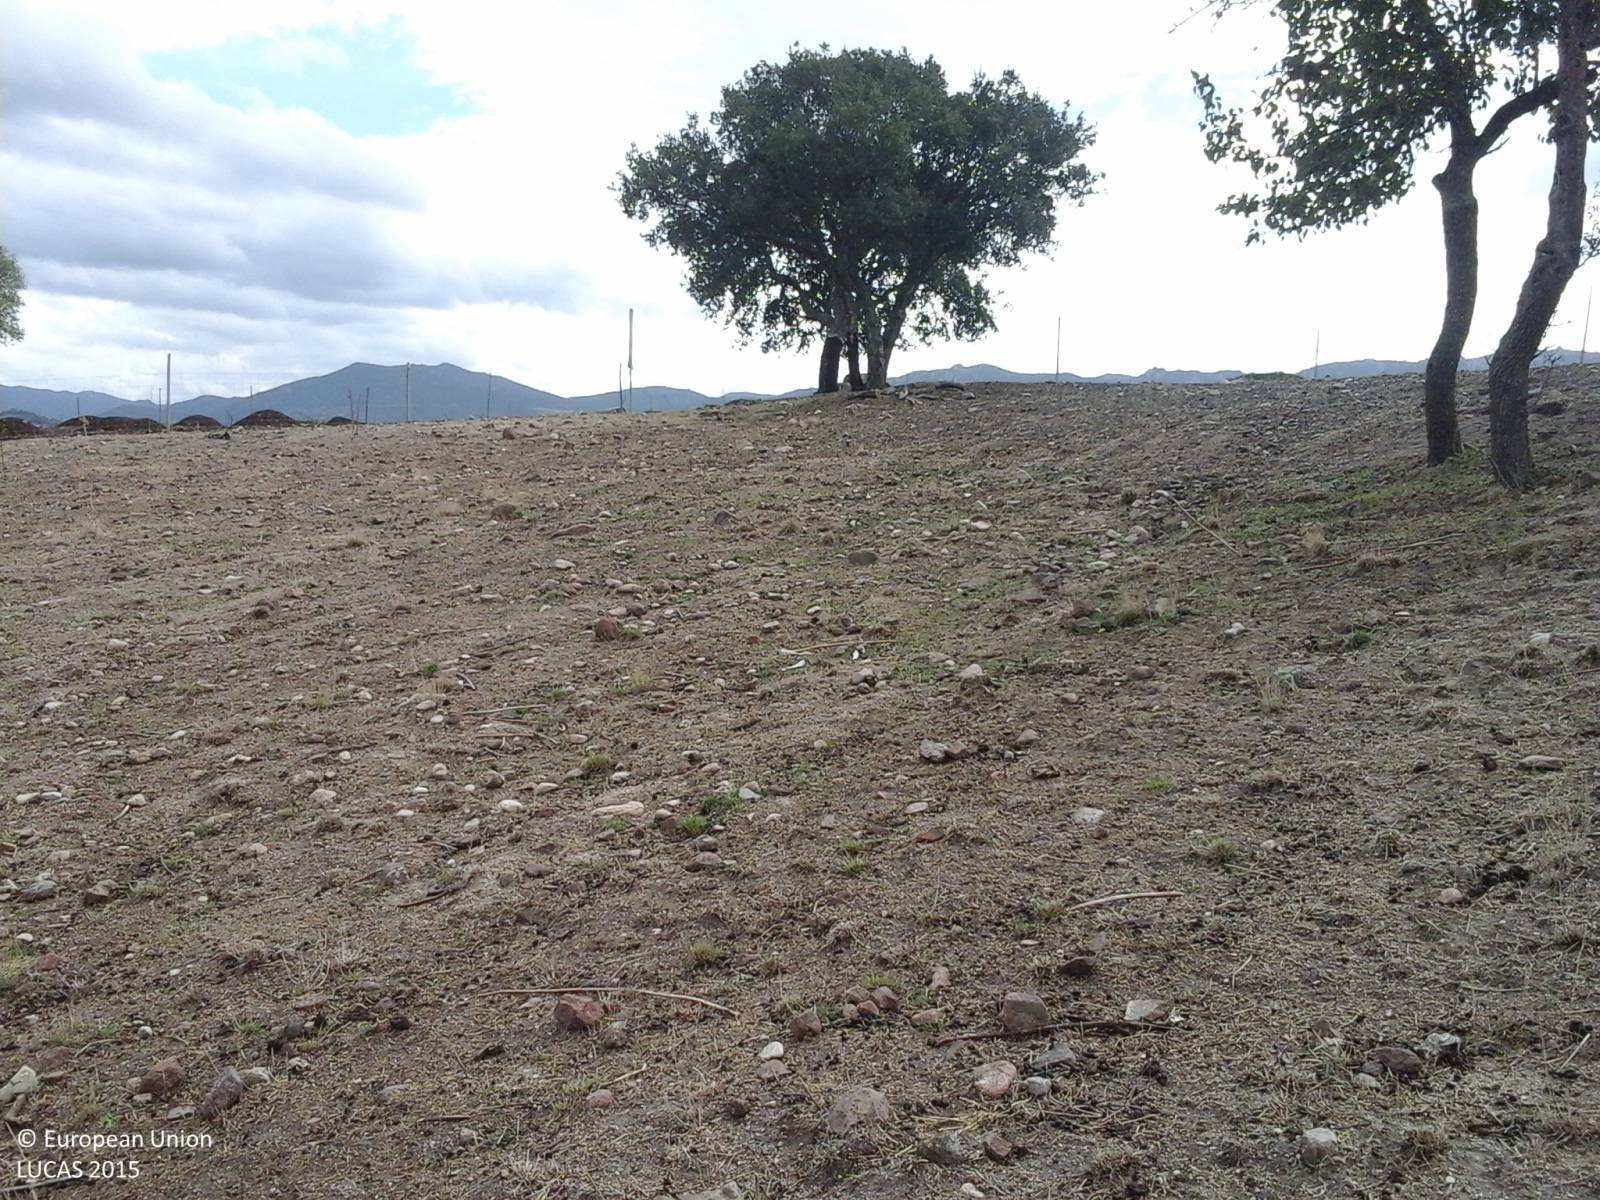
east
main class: Grassland
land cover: Grassland with sparse tree/shrub cover
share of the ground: > 75 %
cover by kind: herbaceous plants 95 %, broadleaved forest trees 5 %
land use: Agriculture (excluding fallow land and kitchen gardens)
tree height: < 5 m
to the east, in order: Grassland with sparse tree/shrub cover; Fences; Grassland without tree/shrub cover; Grassland with sparse tree/shrub cover; Fences; Grassland with sparse tree/shrub cover; Grassland without tree/shrub cover
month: October
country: IT
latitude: 40.1354
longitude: 8.9844
